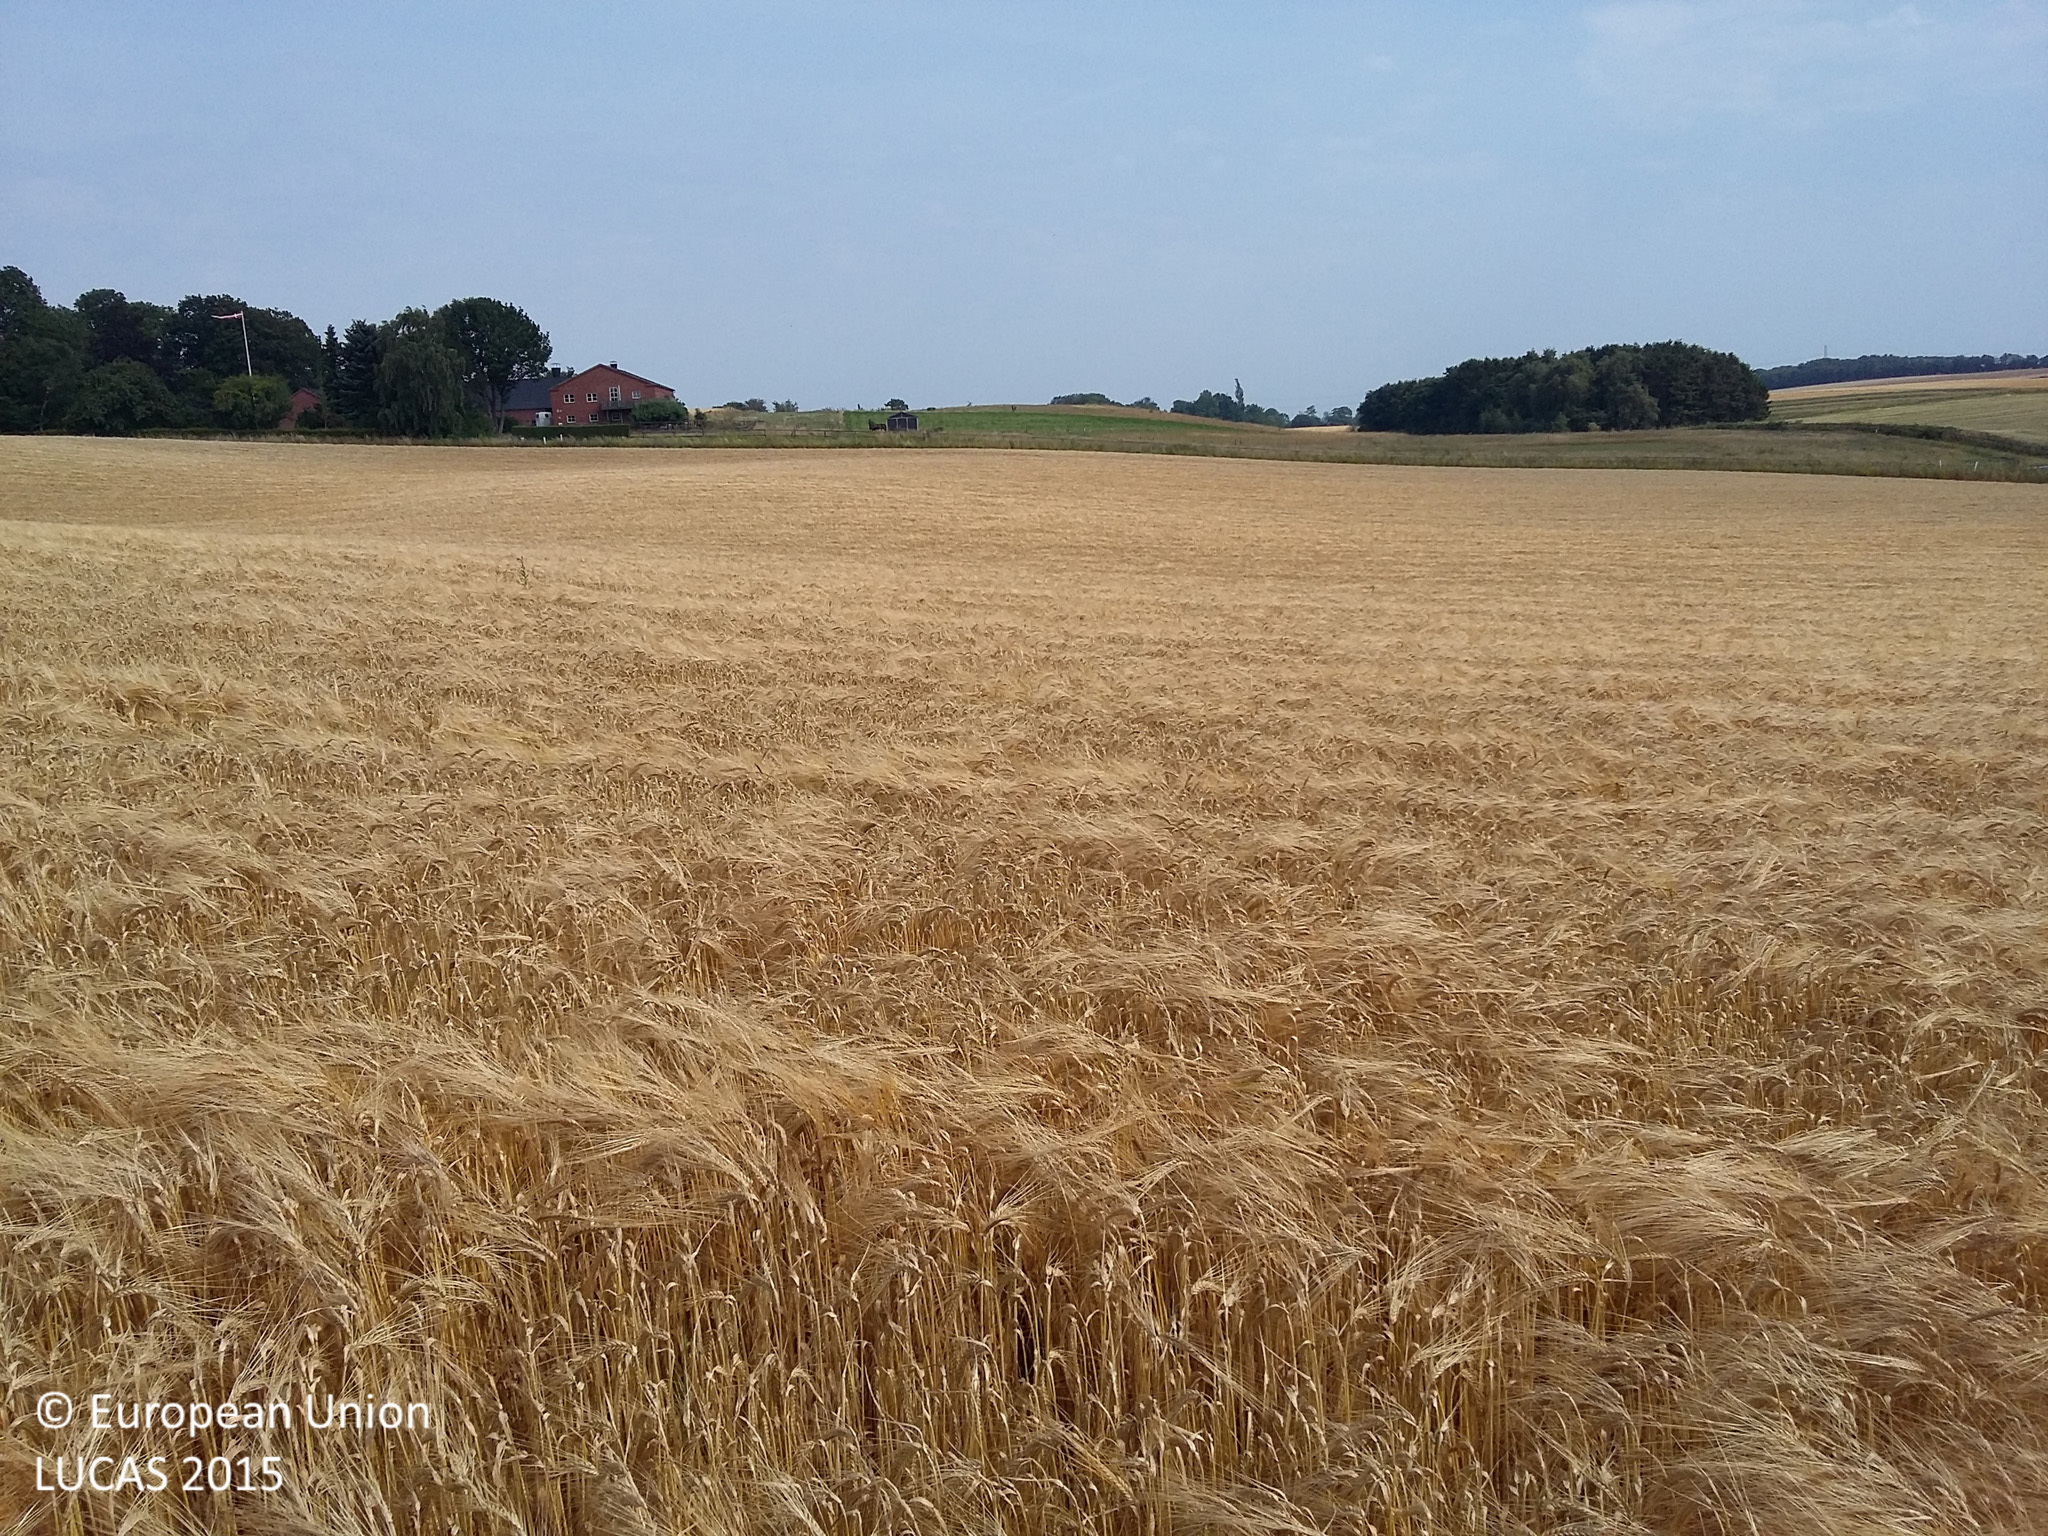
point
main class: Cropland
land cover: Barley
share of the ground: > 75 %
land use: Agriculture (excluding fallow land and kitchen gardens)
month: August
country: DK
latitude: 55.5057
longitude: 12.0724
